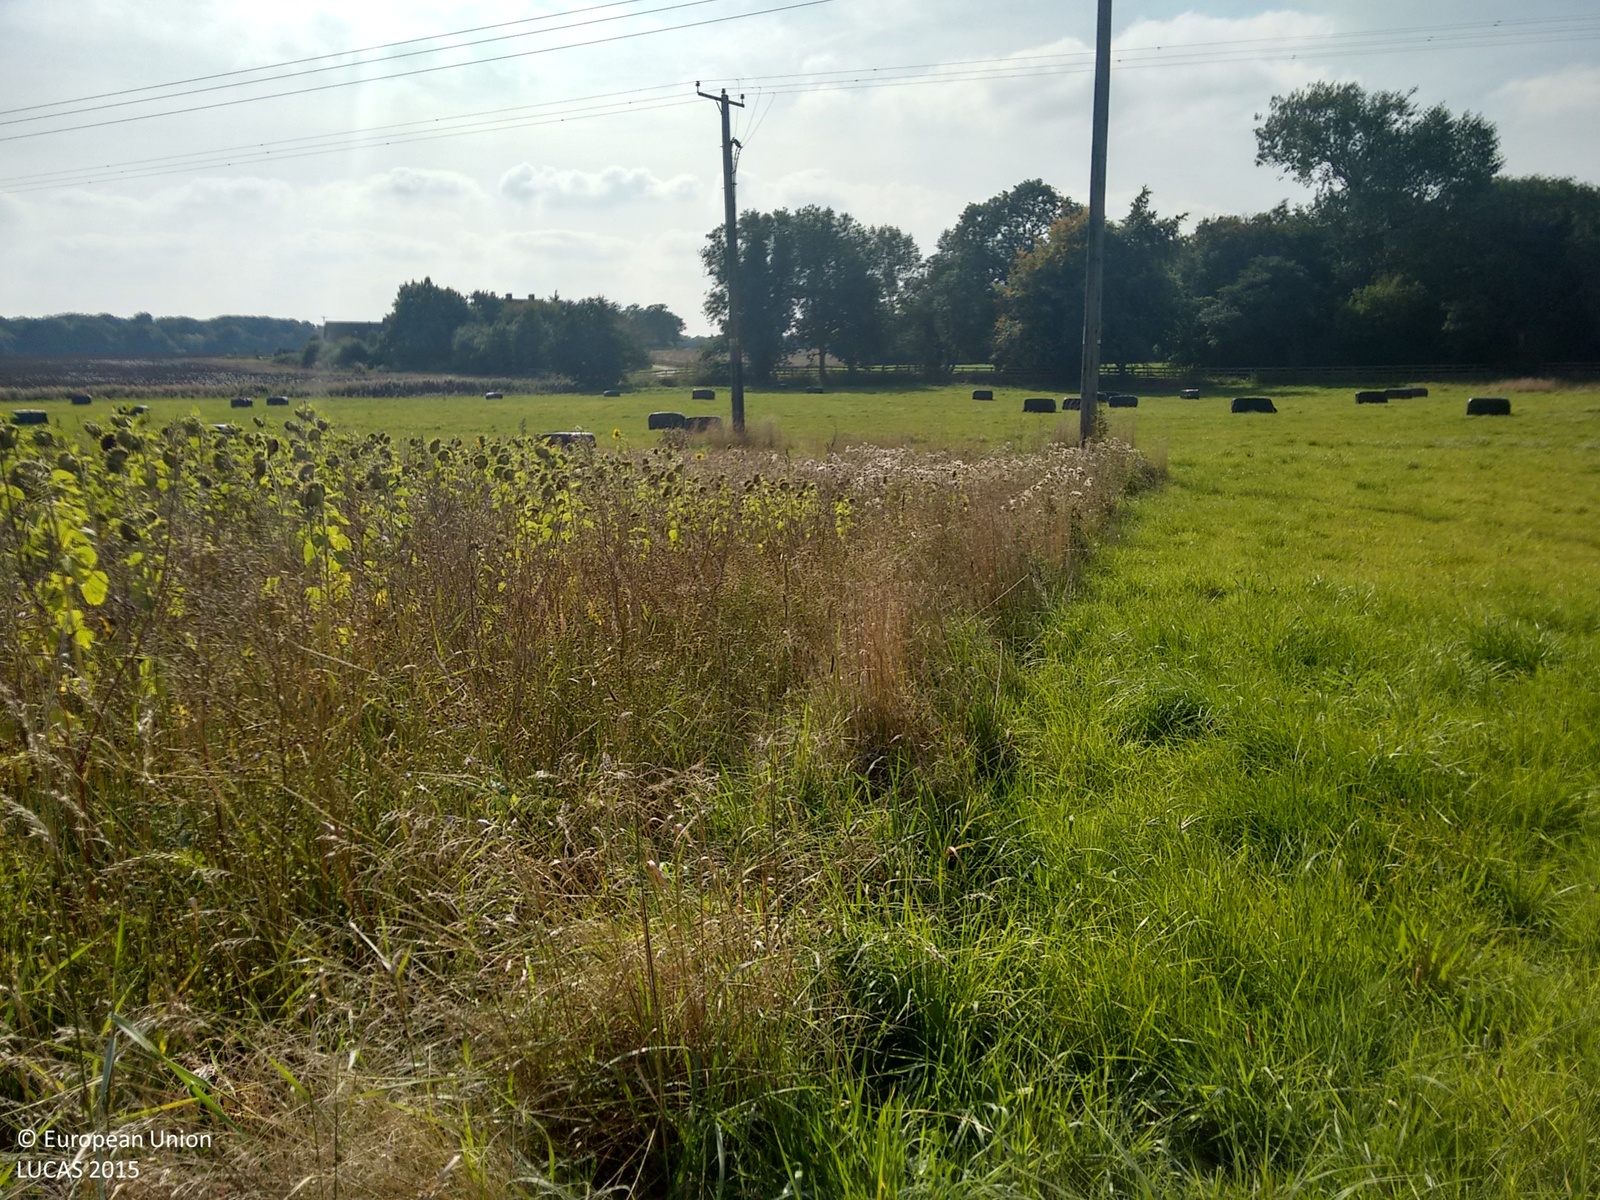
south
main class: Grassland
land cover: Grassland without tree/shrub cover
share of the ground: > 75 %
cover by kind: herbaceous plants 100 %
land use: Agriculture (excluding fallow land and kitchen gardens)
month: September
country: GB
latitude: 52.8081
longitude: -2.3016
